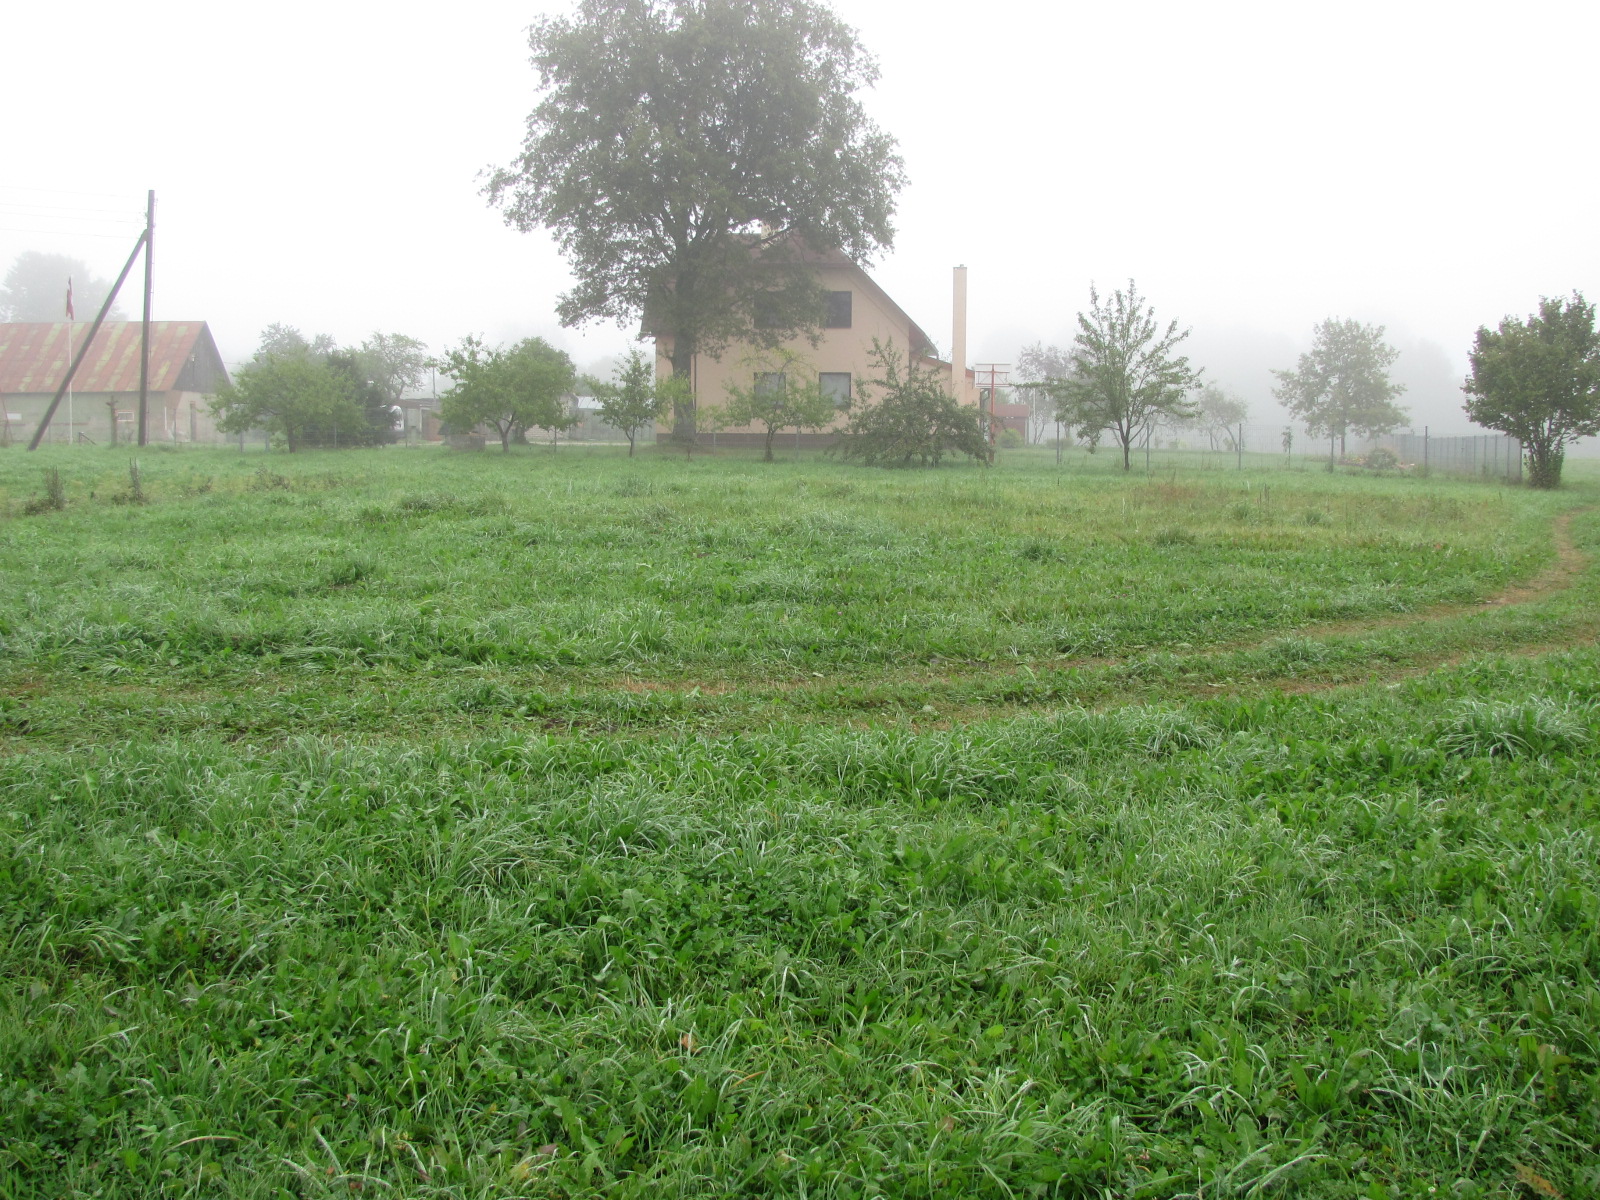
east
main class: Grassland
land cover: Grassland without tree/shrub cover
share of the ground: > 75 %
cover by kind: herbaceous plants 100 %
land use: Agriculture (excluding fallow land and kitchen gardens)
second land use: Residential
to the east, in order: Grassland without tree/shrub cover; Artificial constructions in urban areas; Grassland without tree/shrub cover; Fences; Grassland without tree/shrub cover; Broadleaved woodland
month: September
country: LV
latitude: 56.6152
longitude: 25.1843
